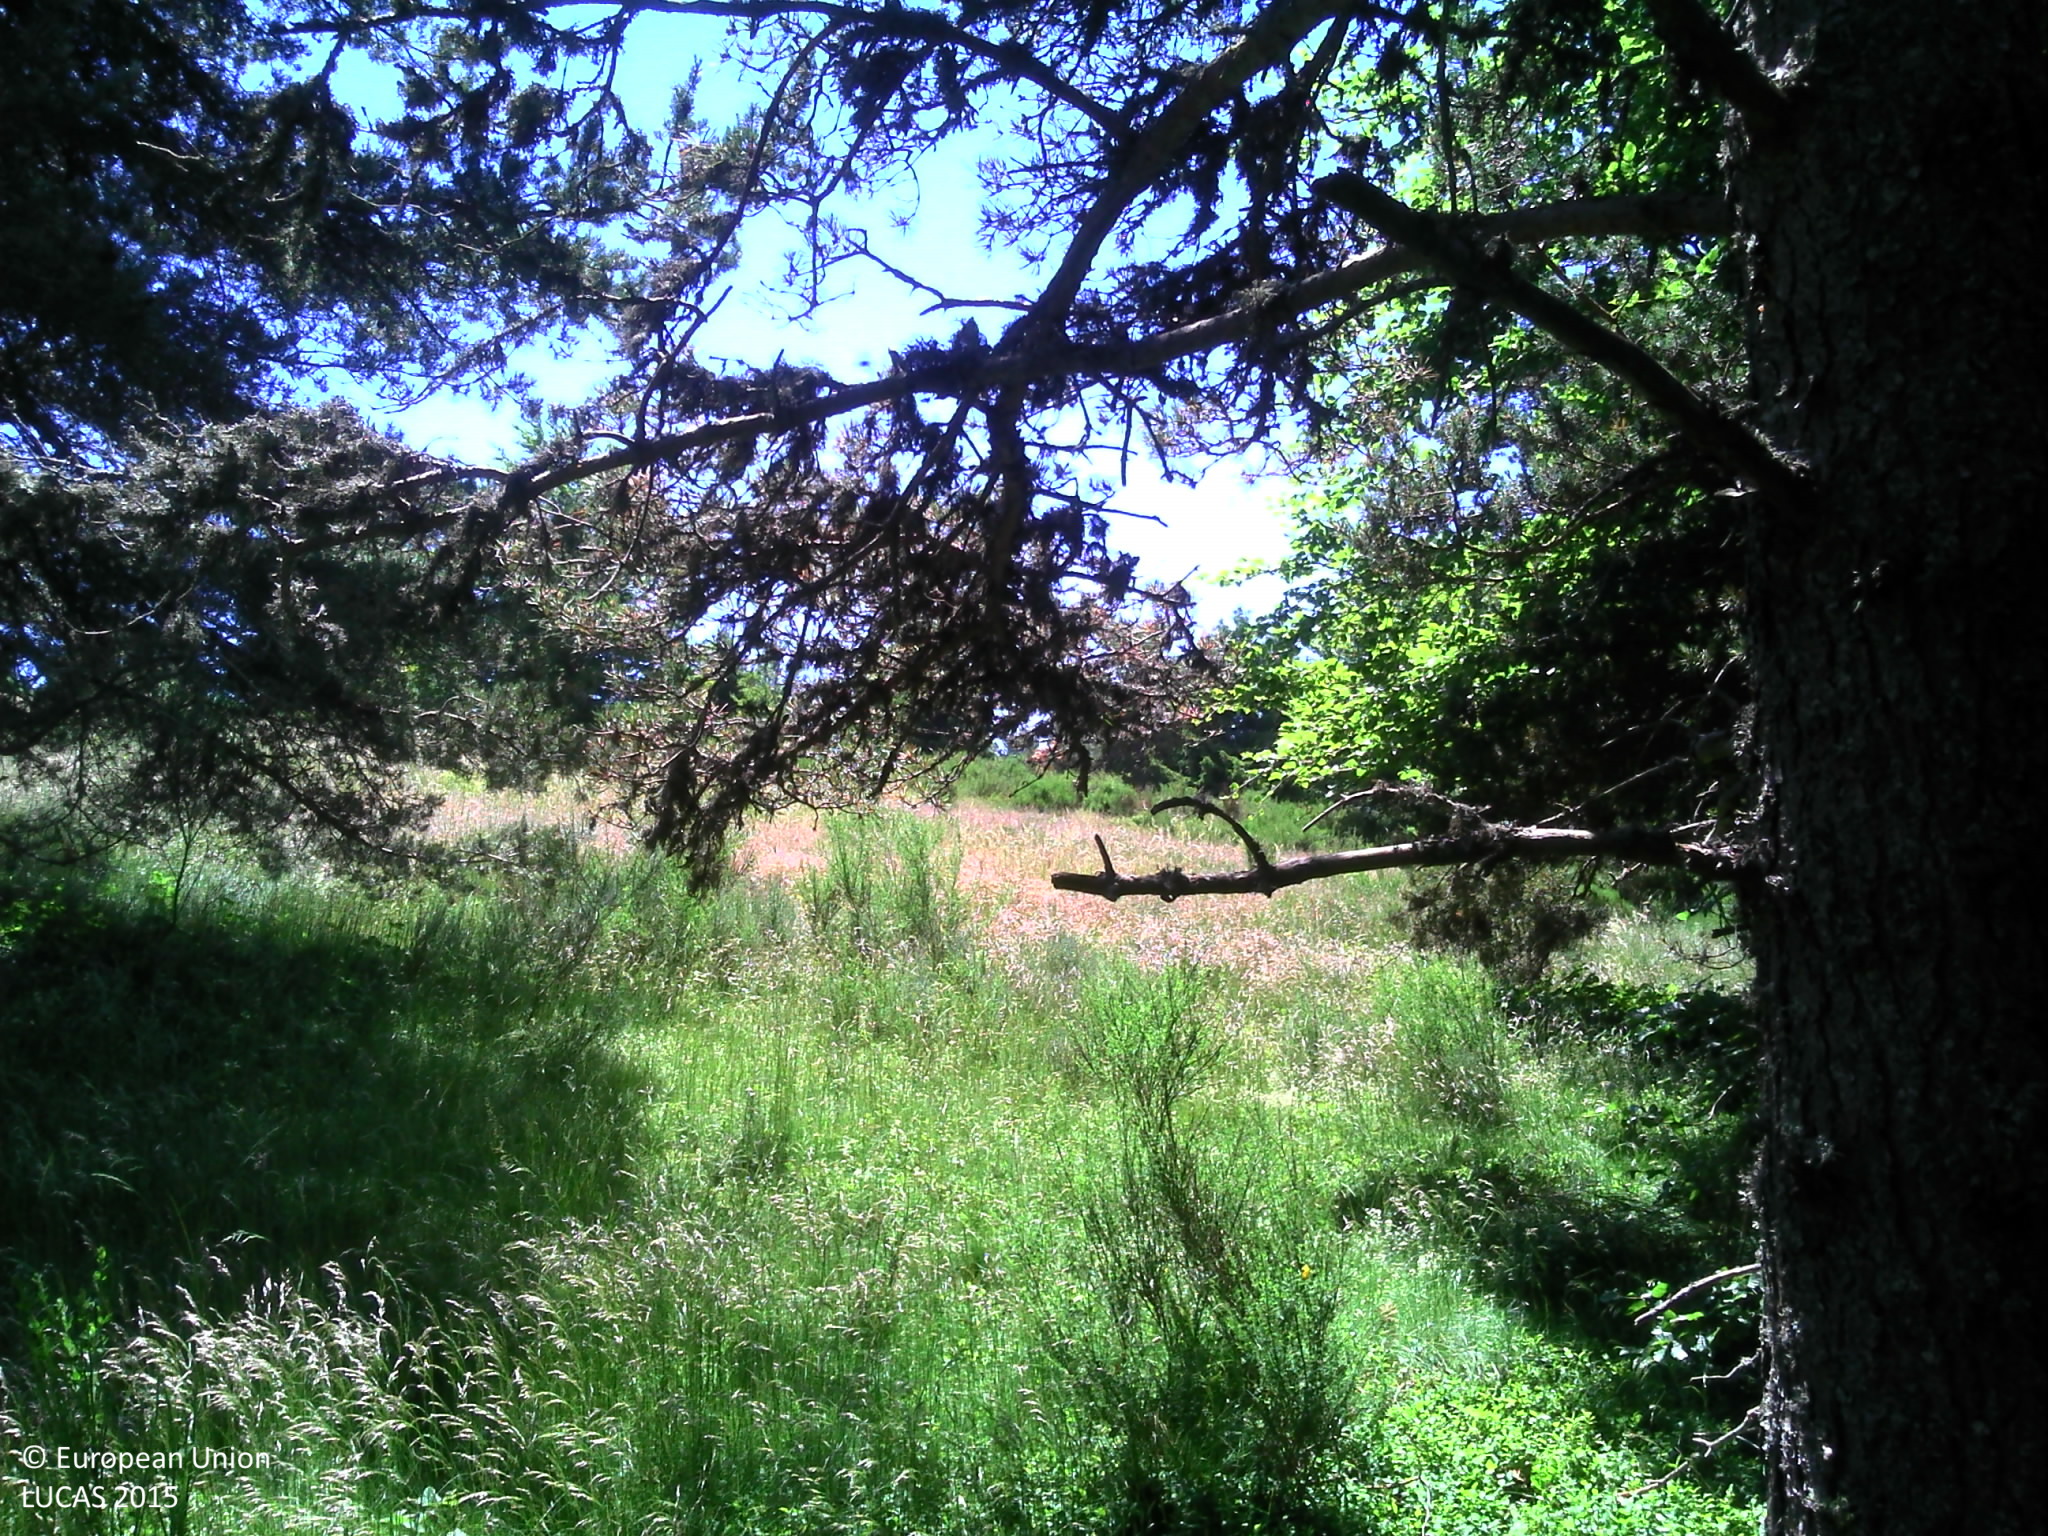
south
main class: Woodland
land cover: Pine dominated mixed woodland
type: mountainous beech forest
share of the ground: 50 - 75 %
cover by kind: herbaceous plants 40 %, broadleaved forest trees 35 %, coniferous forest trees 25 %
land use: Forestry
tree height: > 5 m
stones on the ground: 10 - 25 %
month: June
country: FR
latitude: 44.5788
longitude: 3.4686
